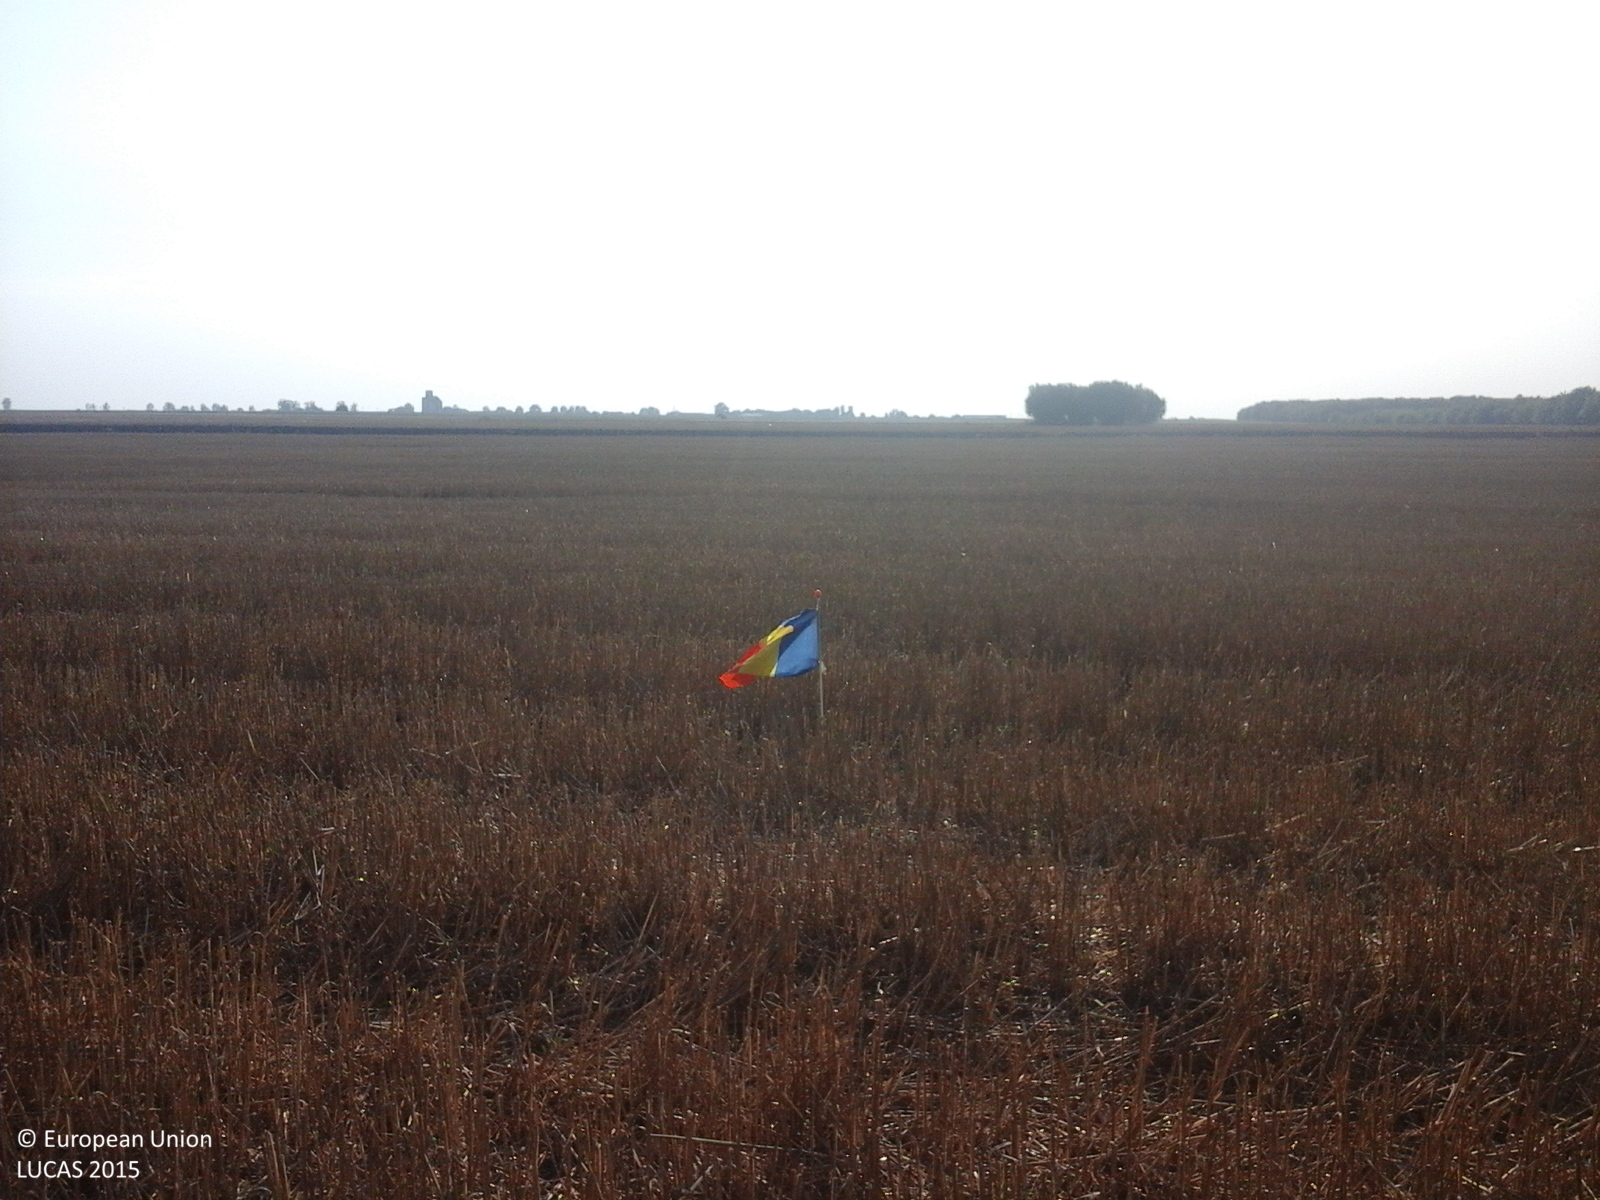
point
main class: Cropland
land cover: Common wheat
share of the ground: > 75 %
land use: Agriculture (excluding fallow land and kitchen gardens)
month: August
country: RO
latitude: 44.0582
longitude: 28.2740
